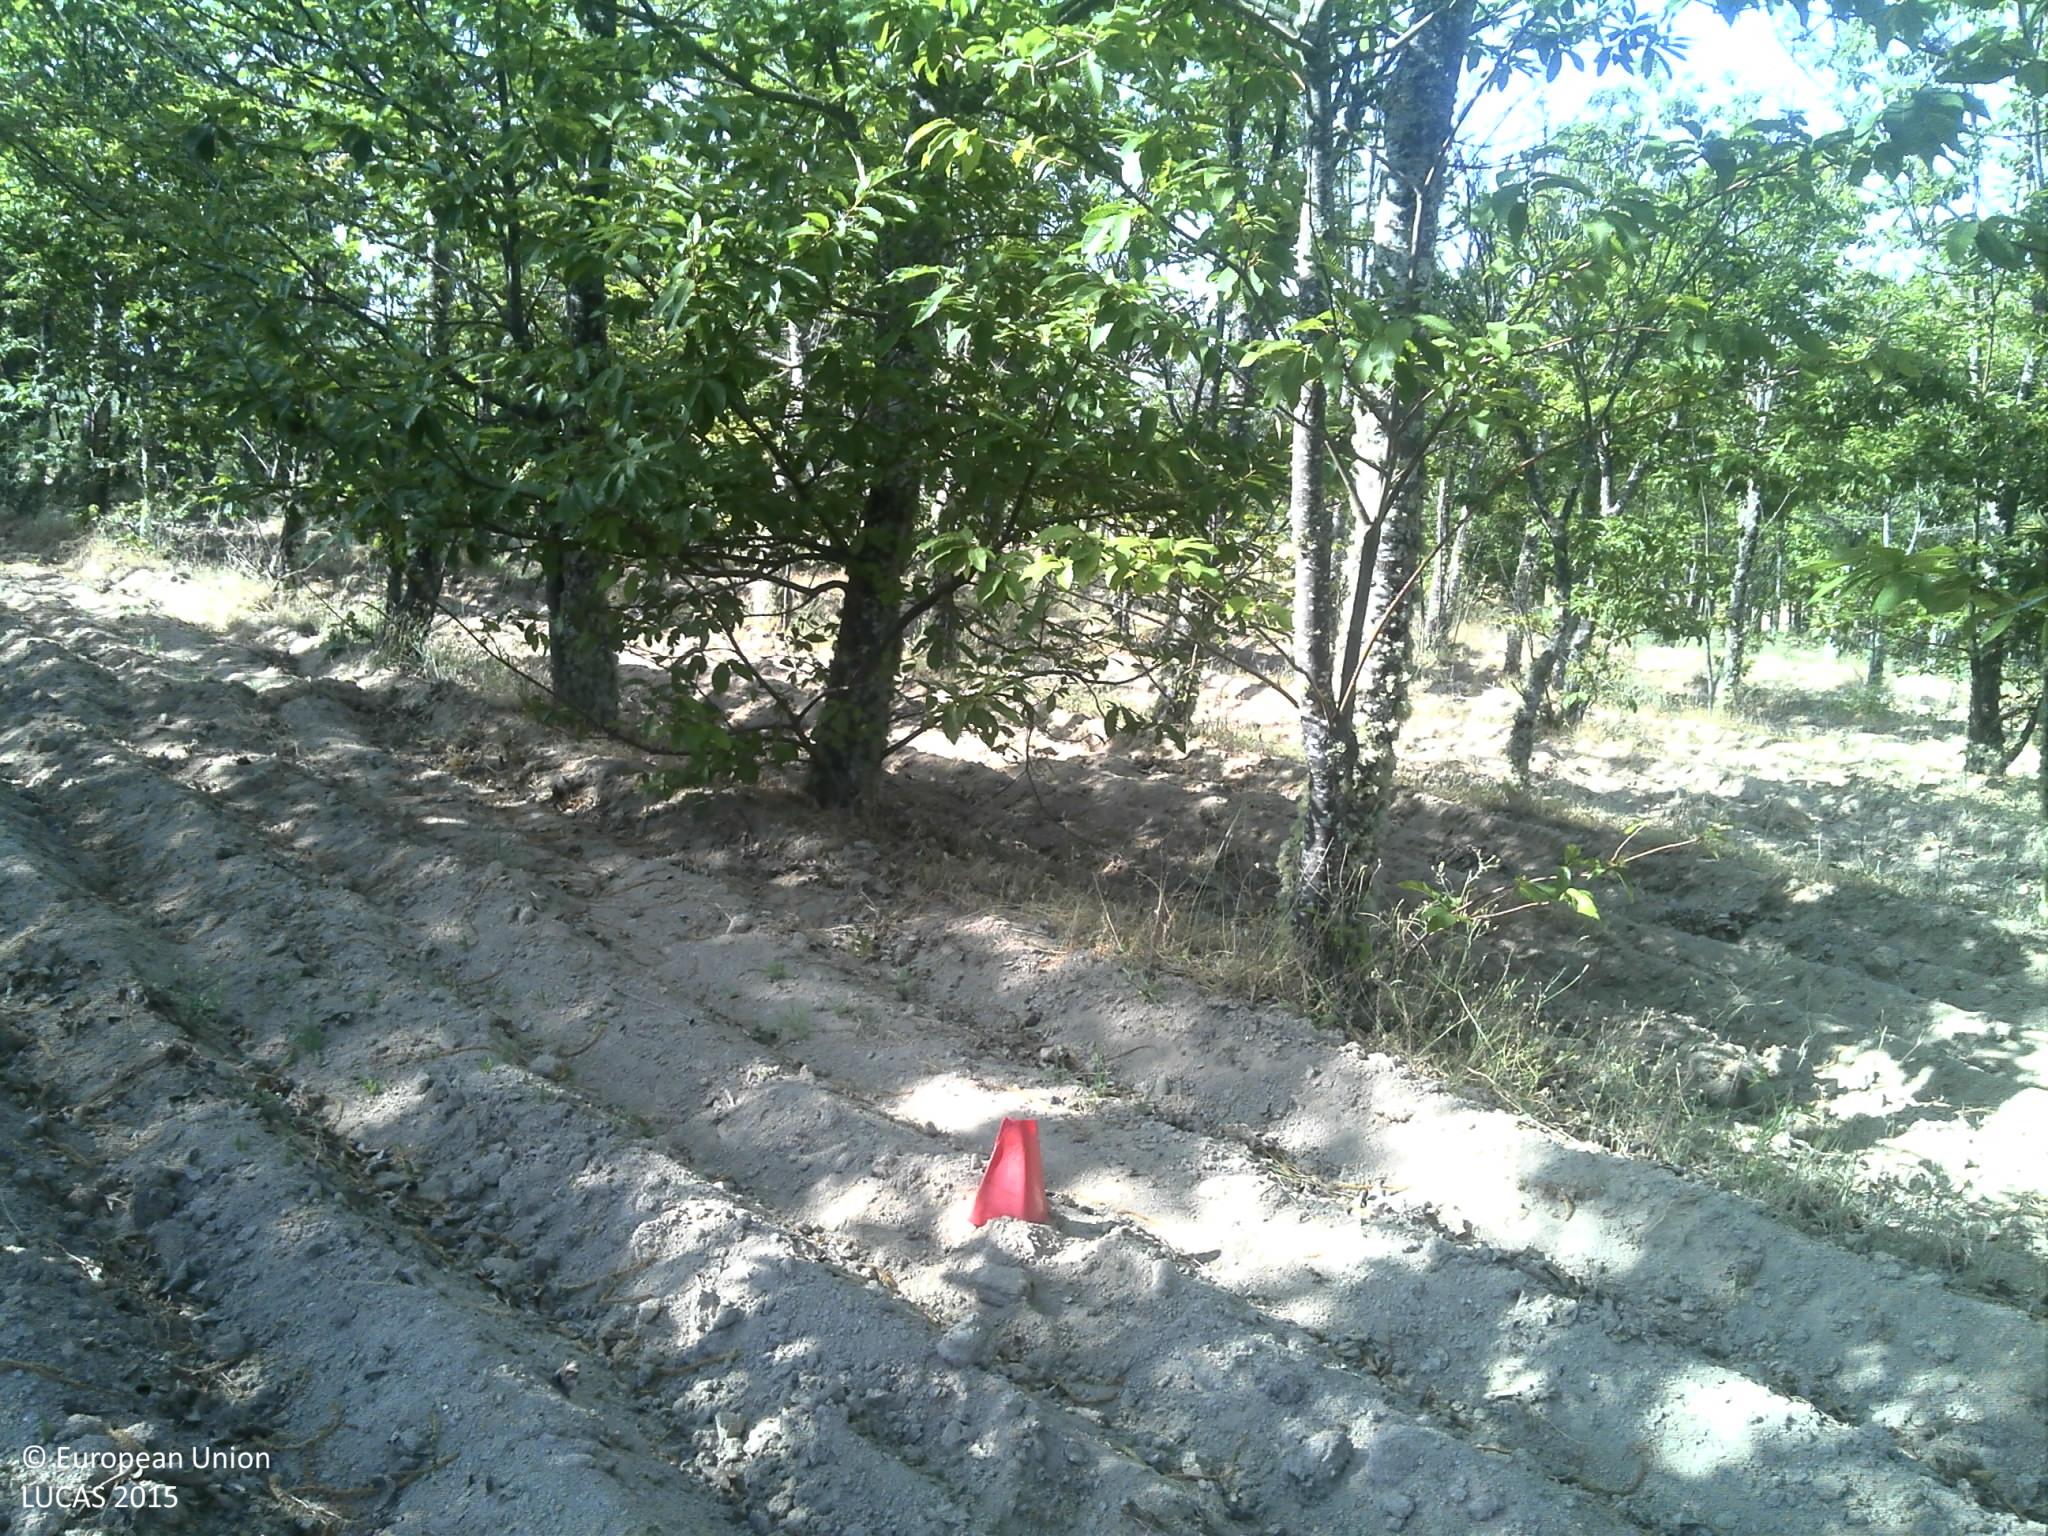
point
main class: Cropland
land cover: Nuts trees
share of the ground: 50 - 75 %
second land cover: Other bare soil
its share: > 75 %
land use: Agriculture (excluding fallow land and kitchen gardens)
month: July
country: PT
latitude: 40.8527
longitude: -7.3244
